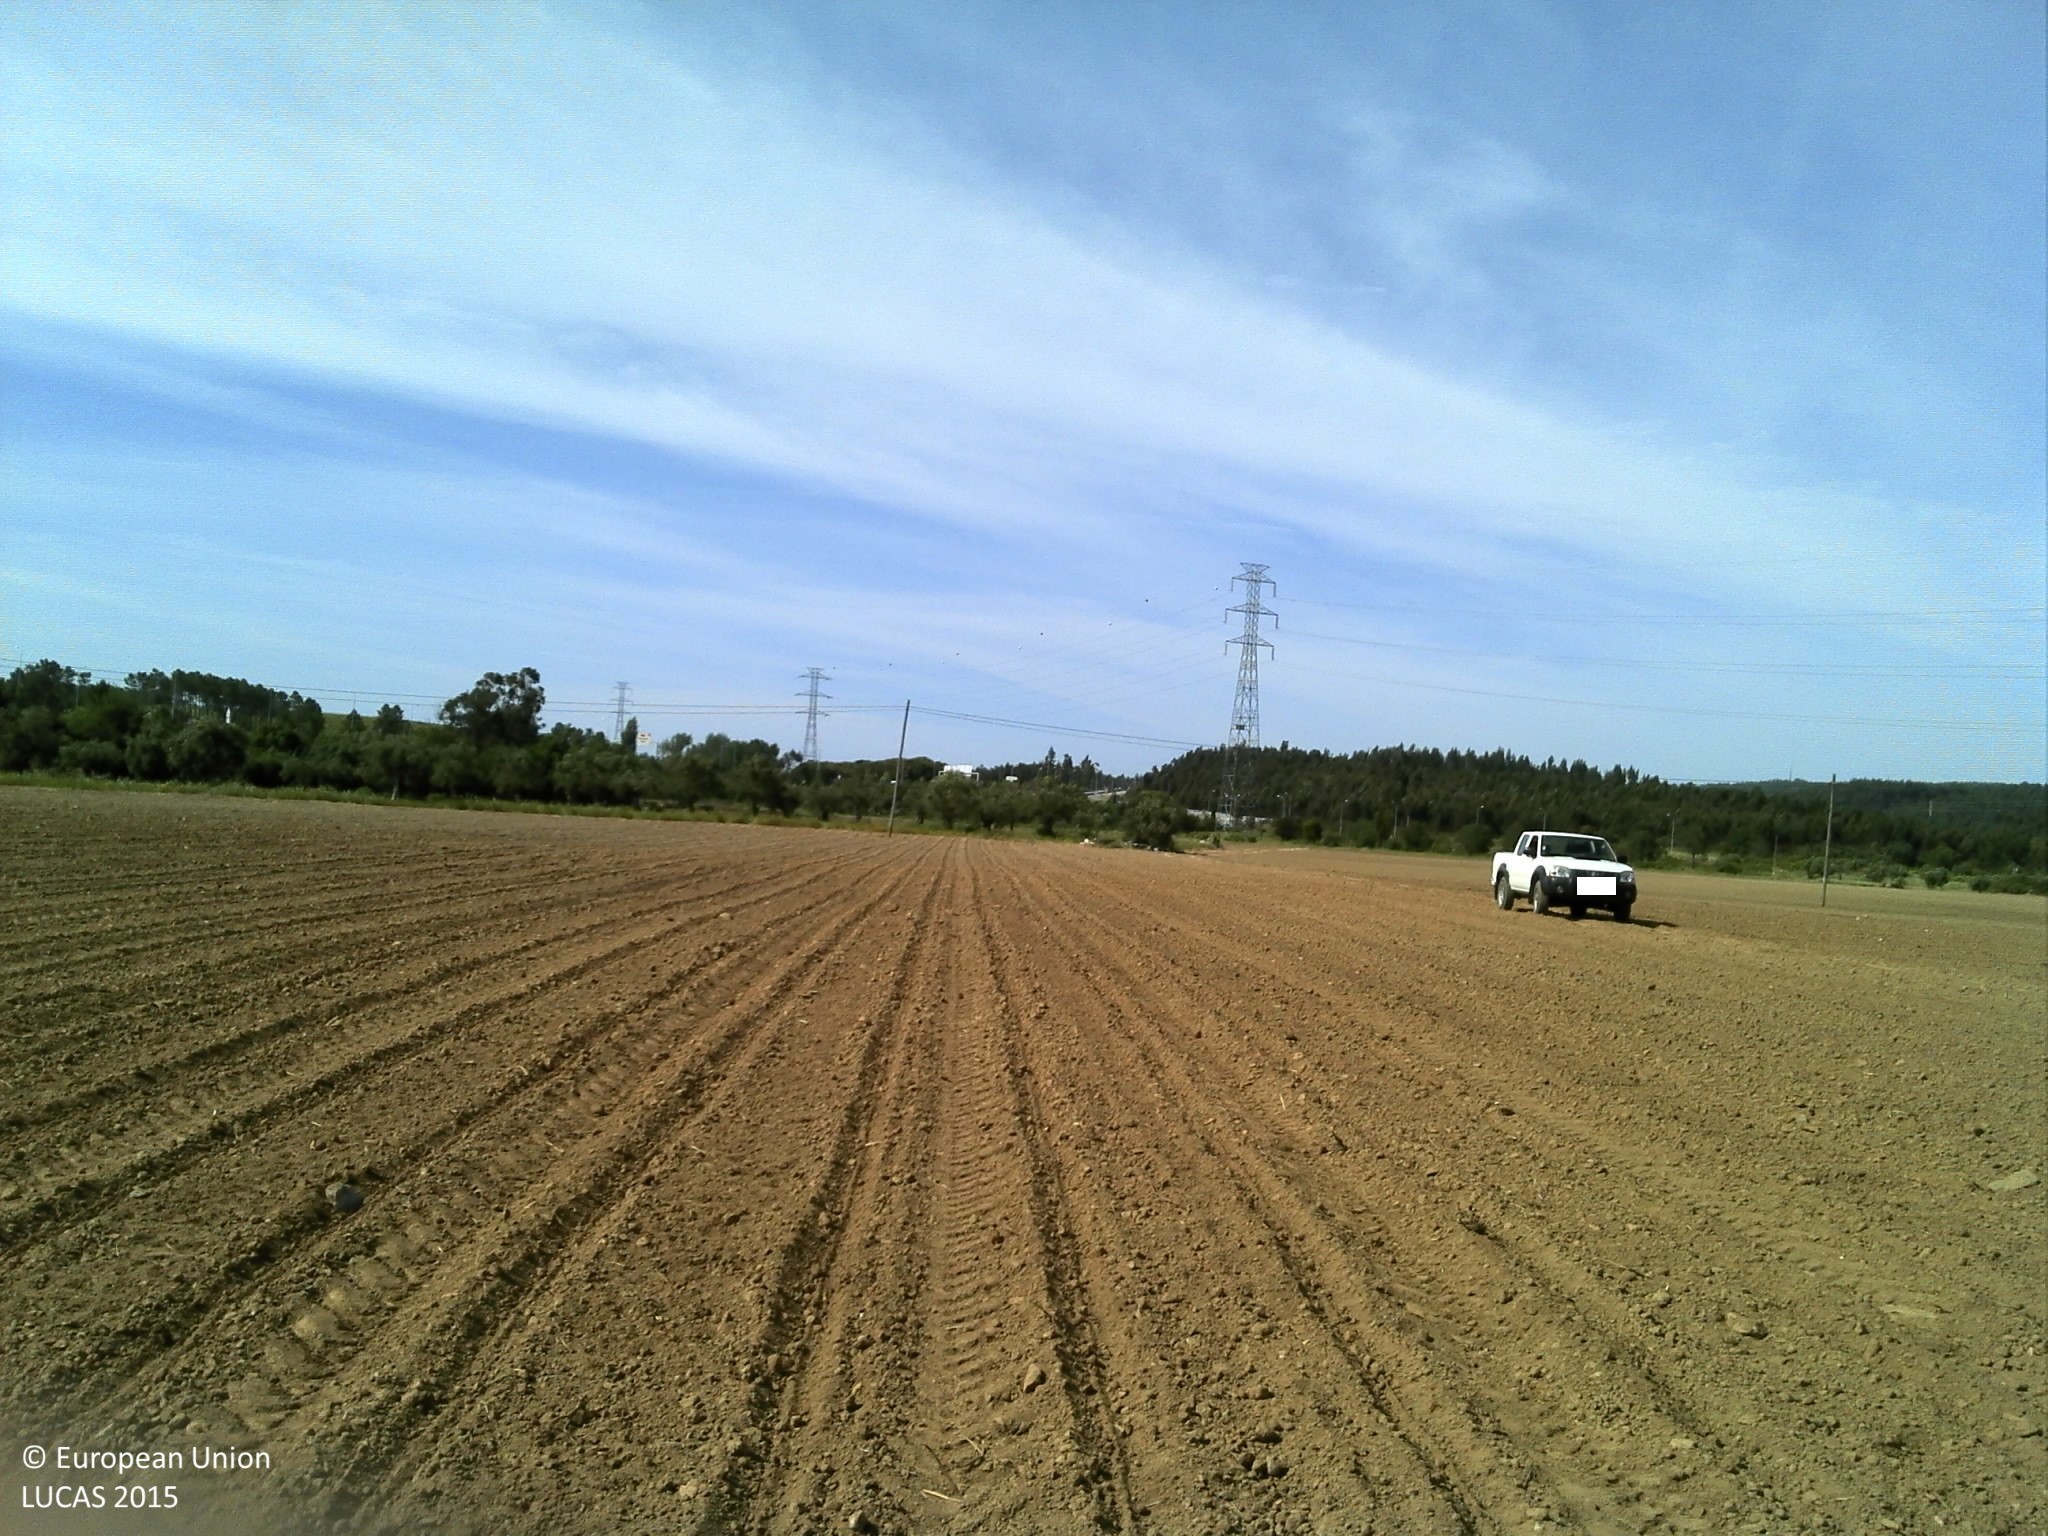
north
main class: Cropland
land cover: Maize
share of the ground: < 10 %
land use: Agriculture (excluding fallow land and kitchen gardens)
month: May
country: PT
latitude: 39.5900
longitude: -8.3632
